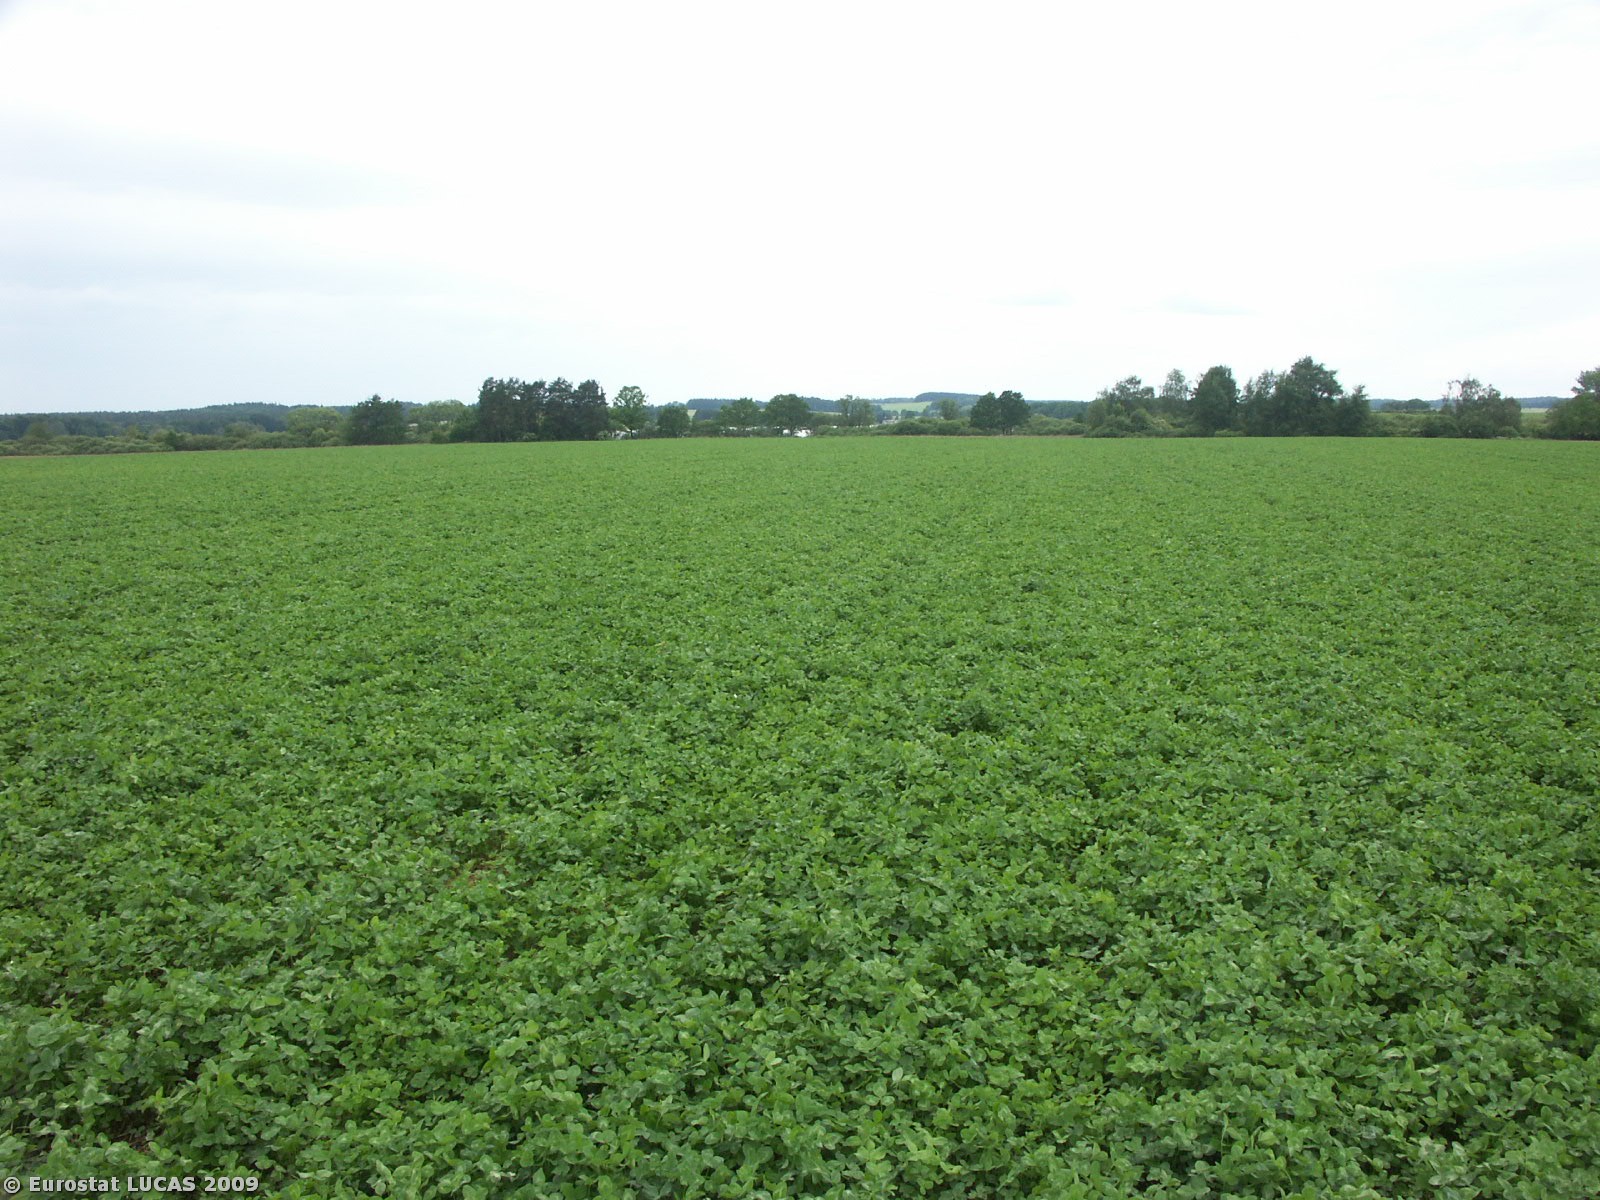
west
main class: Cropland
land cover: Clovers
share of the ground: > 75 %
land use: Agriculture (excluding fallow land and kitchen gardens)
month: June
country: CZ
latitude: 48.9721
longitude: 14.6599
